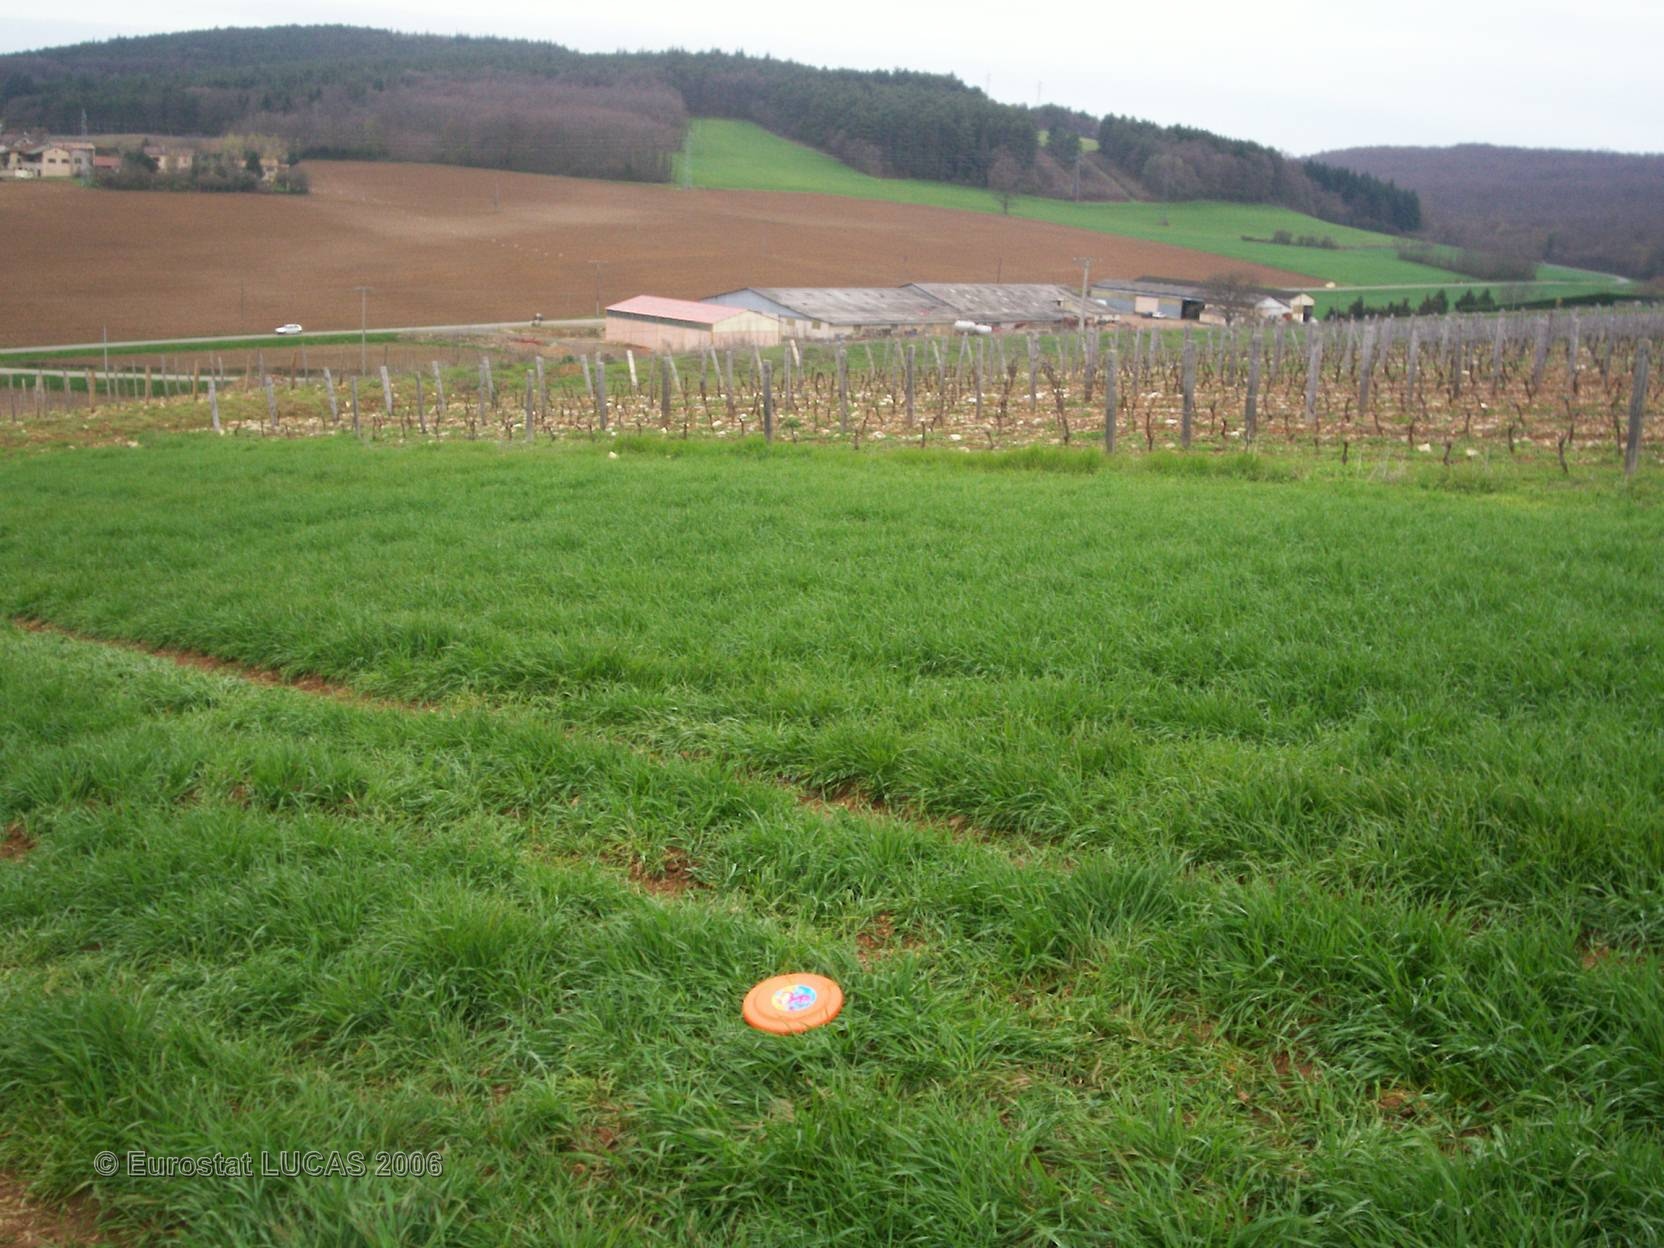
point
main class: Cropland
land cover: Barley
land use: Agriculture (excluding fallow land and kitchen gardens)
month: April
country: FR
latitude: 46.3494
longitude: 4.7653
